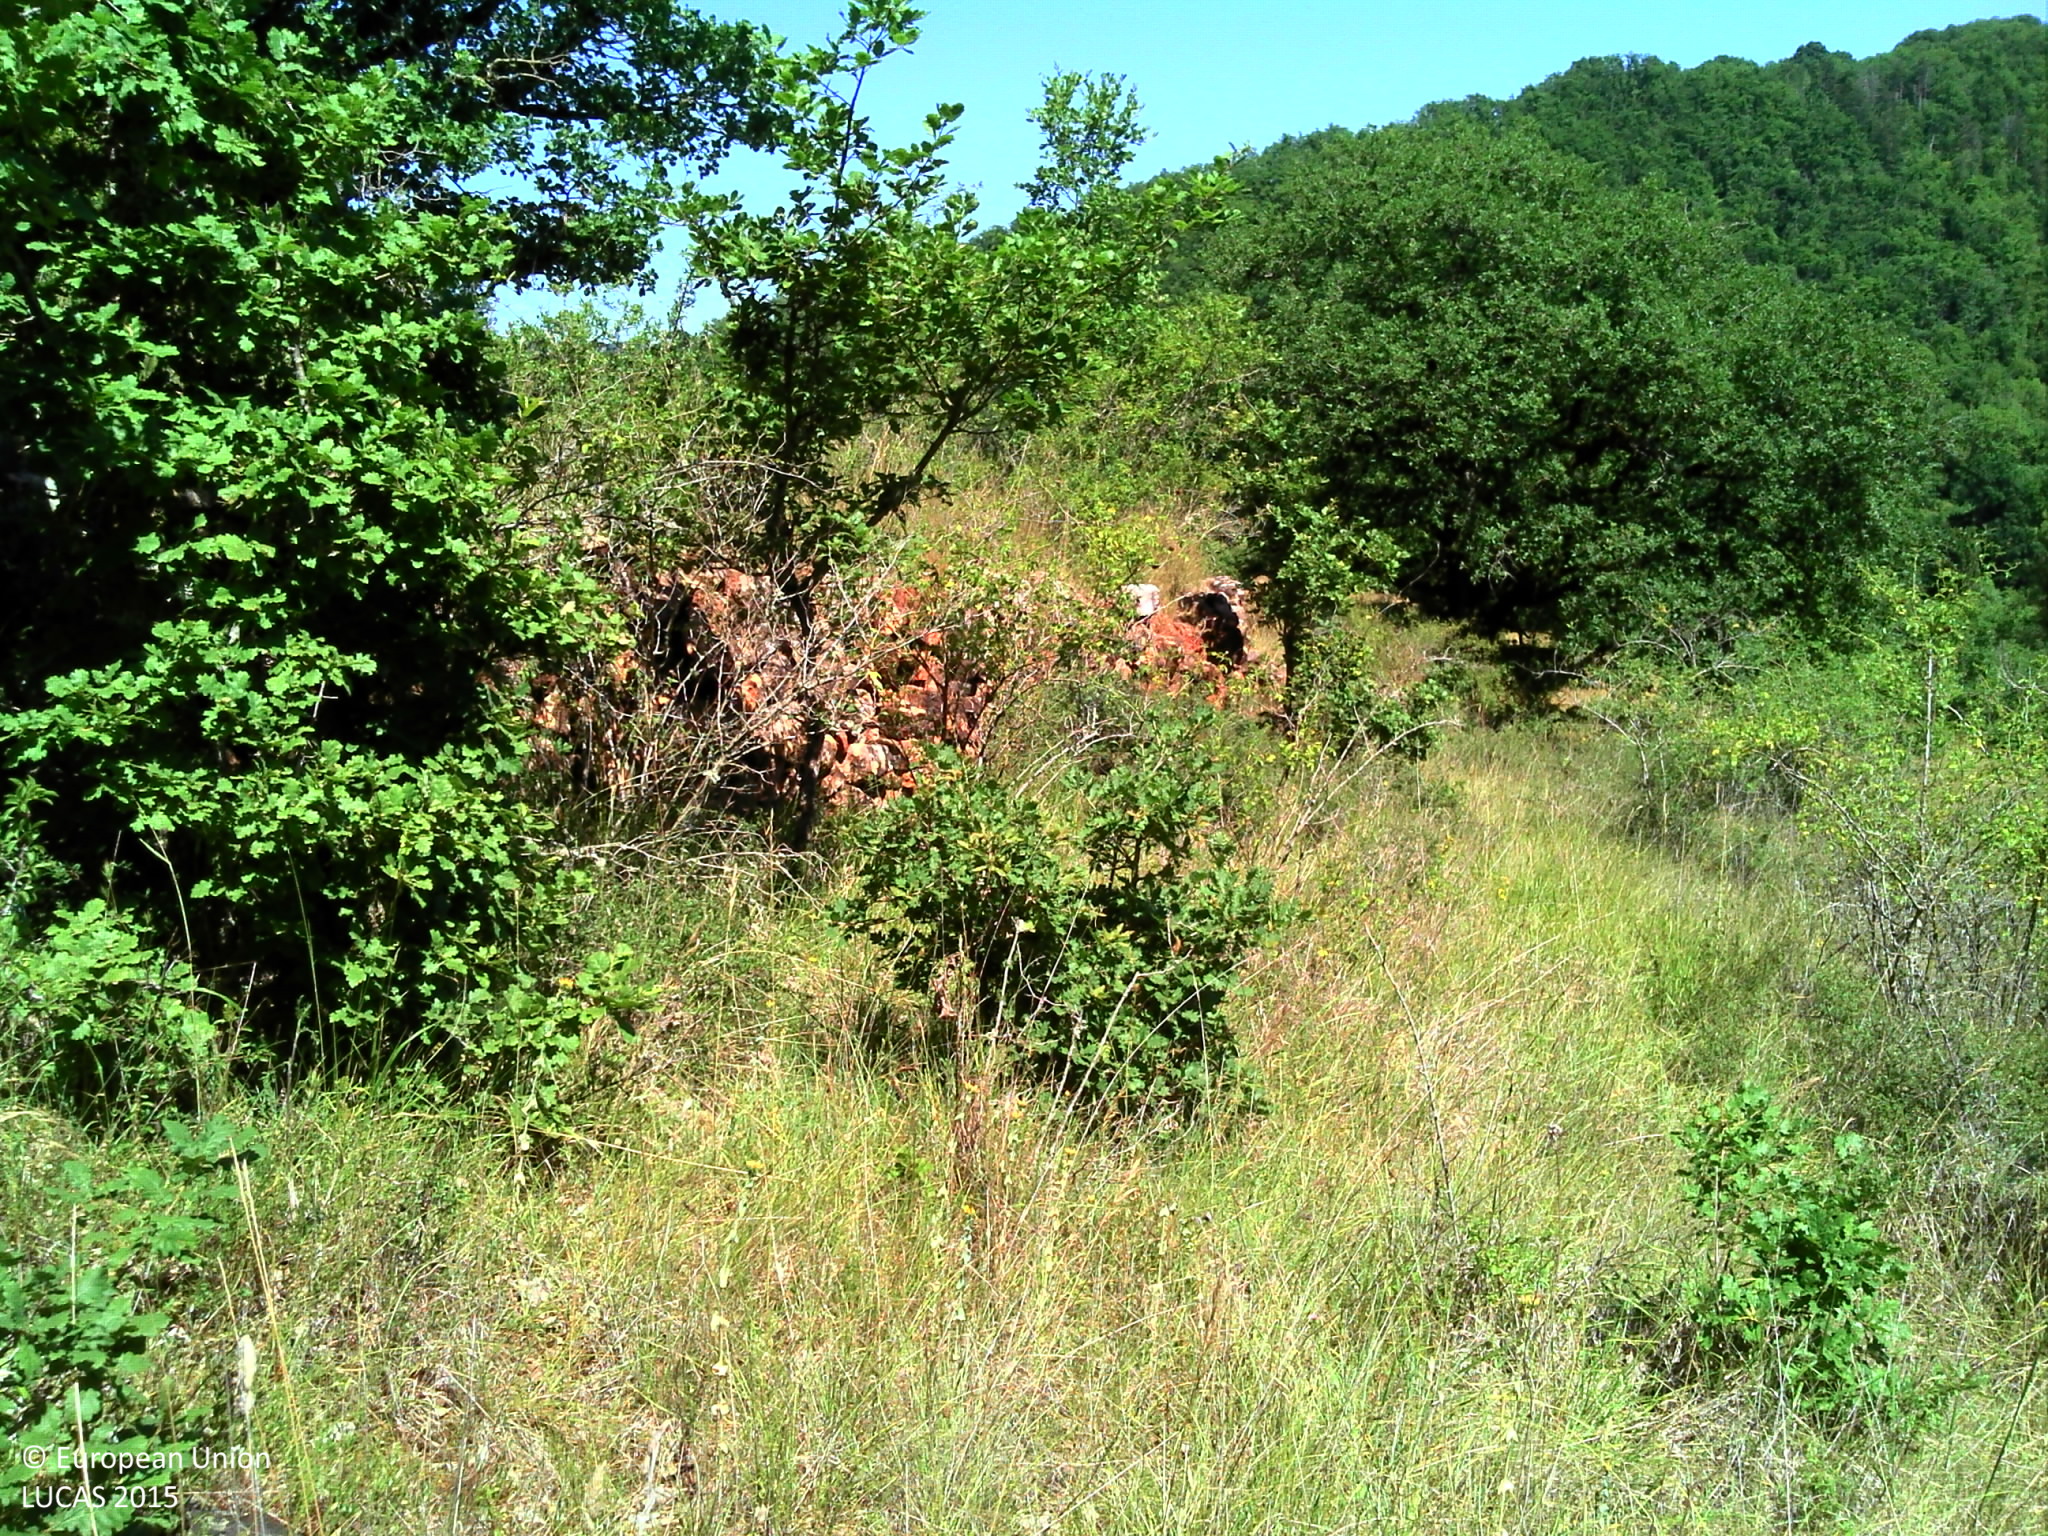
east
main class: Shrubland
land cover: Shrubland with sparse tree cover
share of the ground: > 75 %
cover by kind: shrubs 95 %, broadleaved forest trees 5 %
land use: Agriculture (excluding fallow land and kitchen gardens)
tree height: > 5 m
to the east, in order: Abandoned hedges; Shrubland with sparse tree cover; Dry stone walls; Shrubland with sparse tree cover; Dry stone walls; Shrubland with sparse tree cover; Dry stone walls; Shrubland with sparse tree cover; Fences; Shrubland with sparse tree cover; Broadleaved woodland; Fences; Broadleaved woodland; Dry stone walls; Fences; Grassland with sparse tree/shrub cover
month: June
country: FR
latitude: 44.4734
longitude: 2.4471
